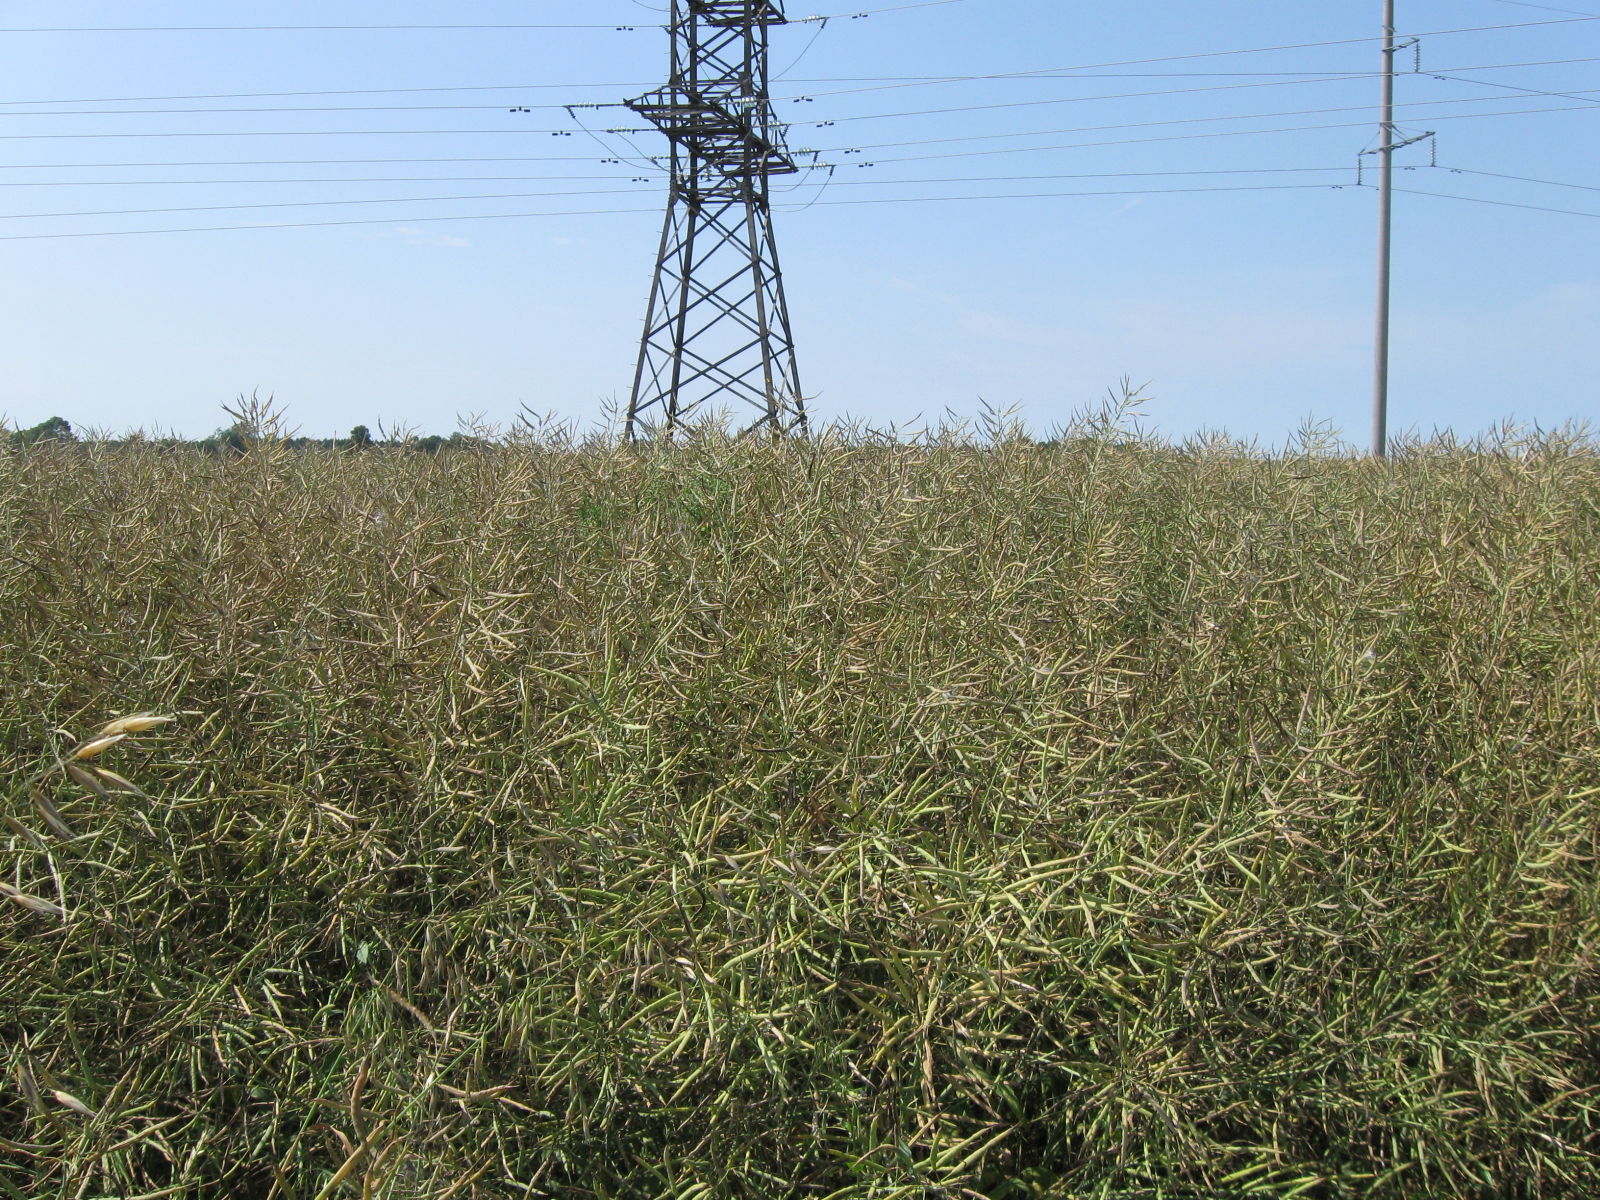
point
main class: Cropland
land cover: Rape and turnip rape
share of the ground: > 75 %
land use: Agriculture (excluding fallow land and kitchen gardens)
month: July
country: LT
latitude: 54.6727
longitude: 23.9380
